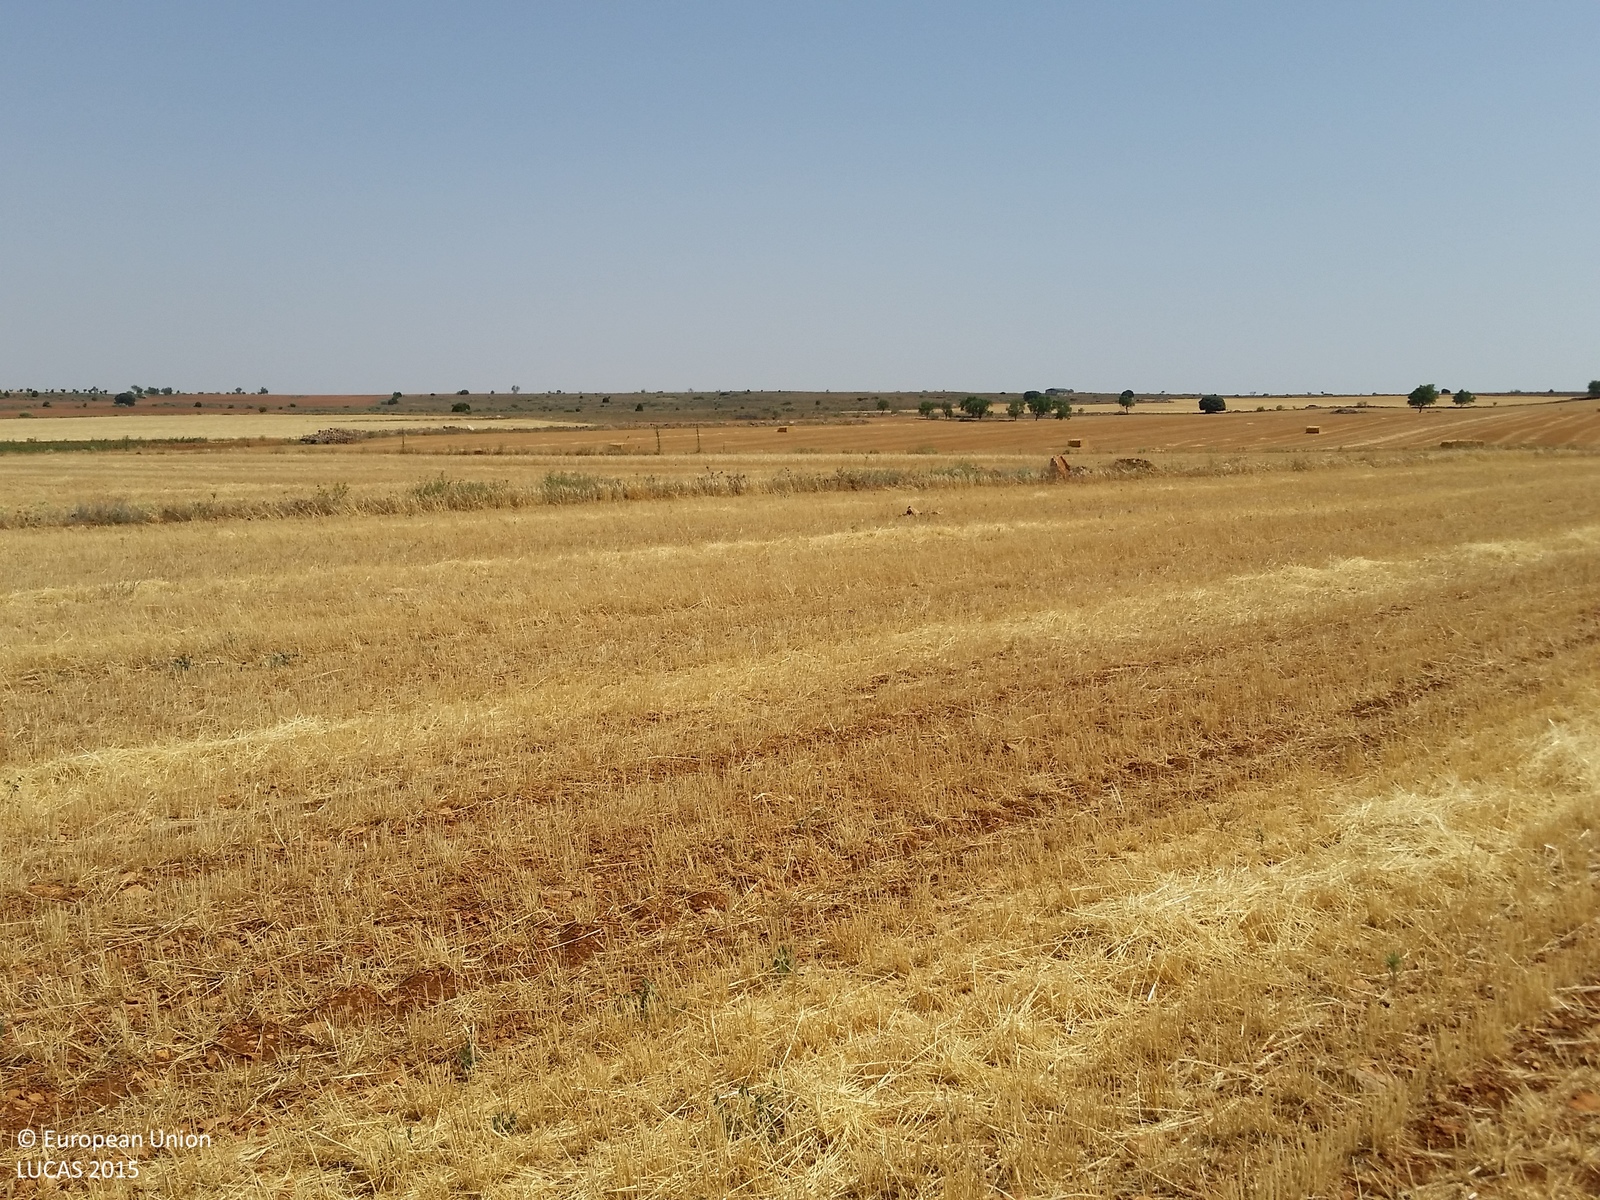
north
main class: Cropland
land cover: Barley
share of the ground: < 10 %
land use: Agriculture (excluding fallow land and kitchen gardens)
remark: Harvested field
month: June
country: ES
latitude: 38.8301
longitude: -2.5947
